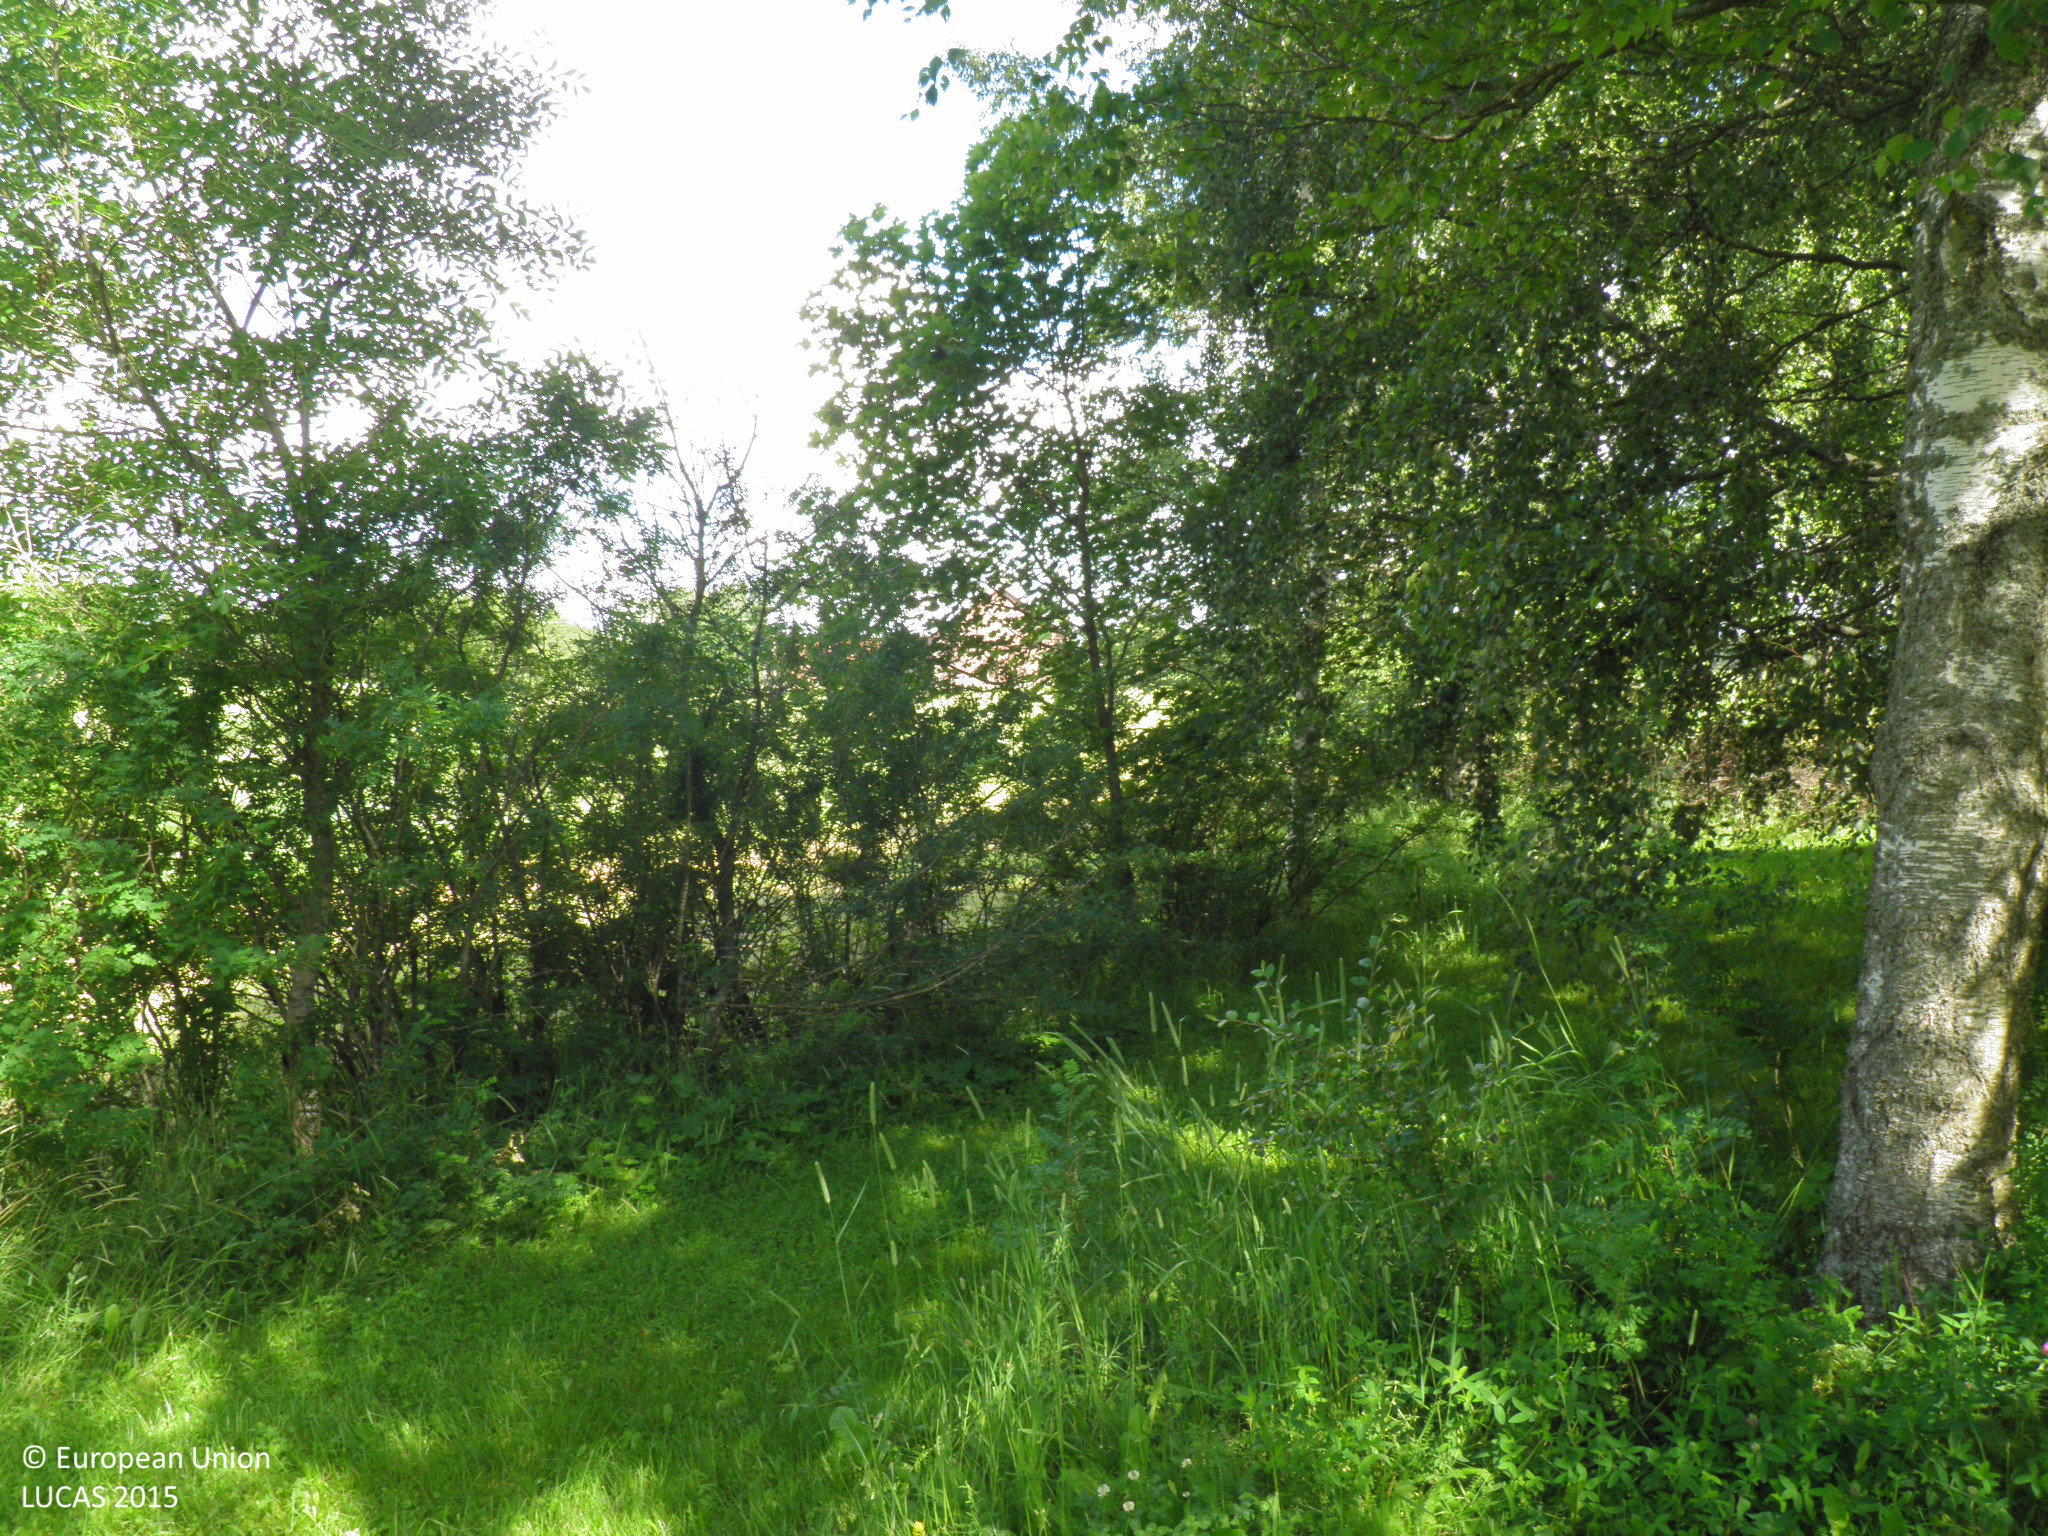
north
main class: Grassland
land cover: Grassland with sparse tree/shrub cover
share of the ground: > 75 %
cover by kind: herbaceous plants 95 %, broadleaved forest trees 5 %
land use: Residential
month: July
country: FI
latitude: 60.7904
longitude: 22.9154
